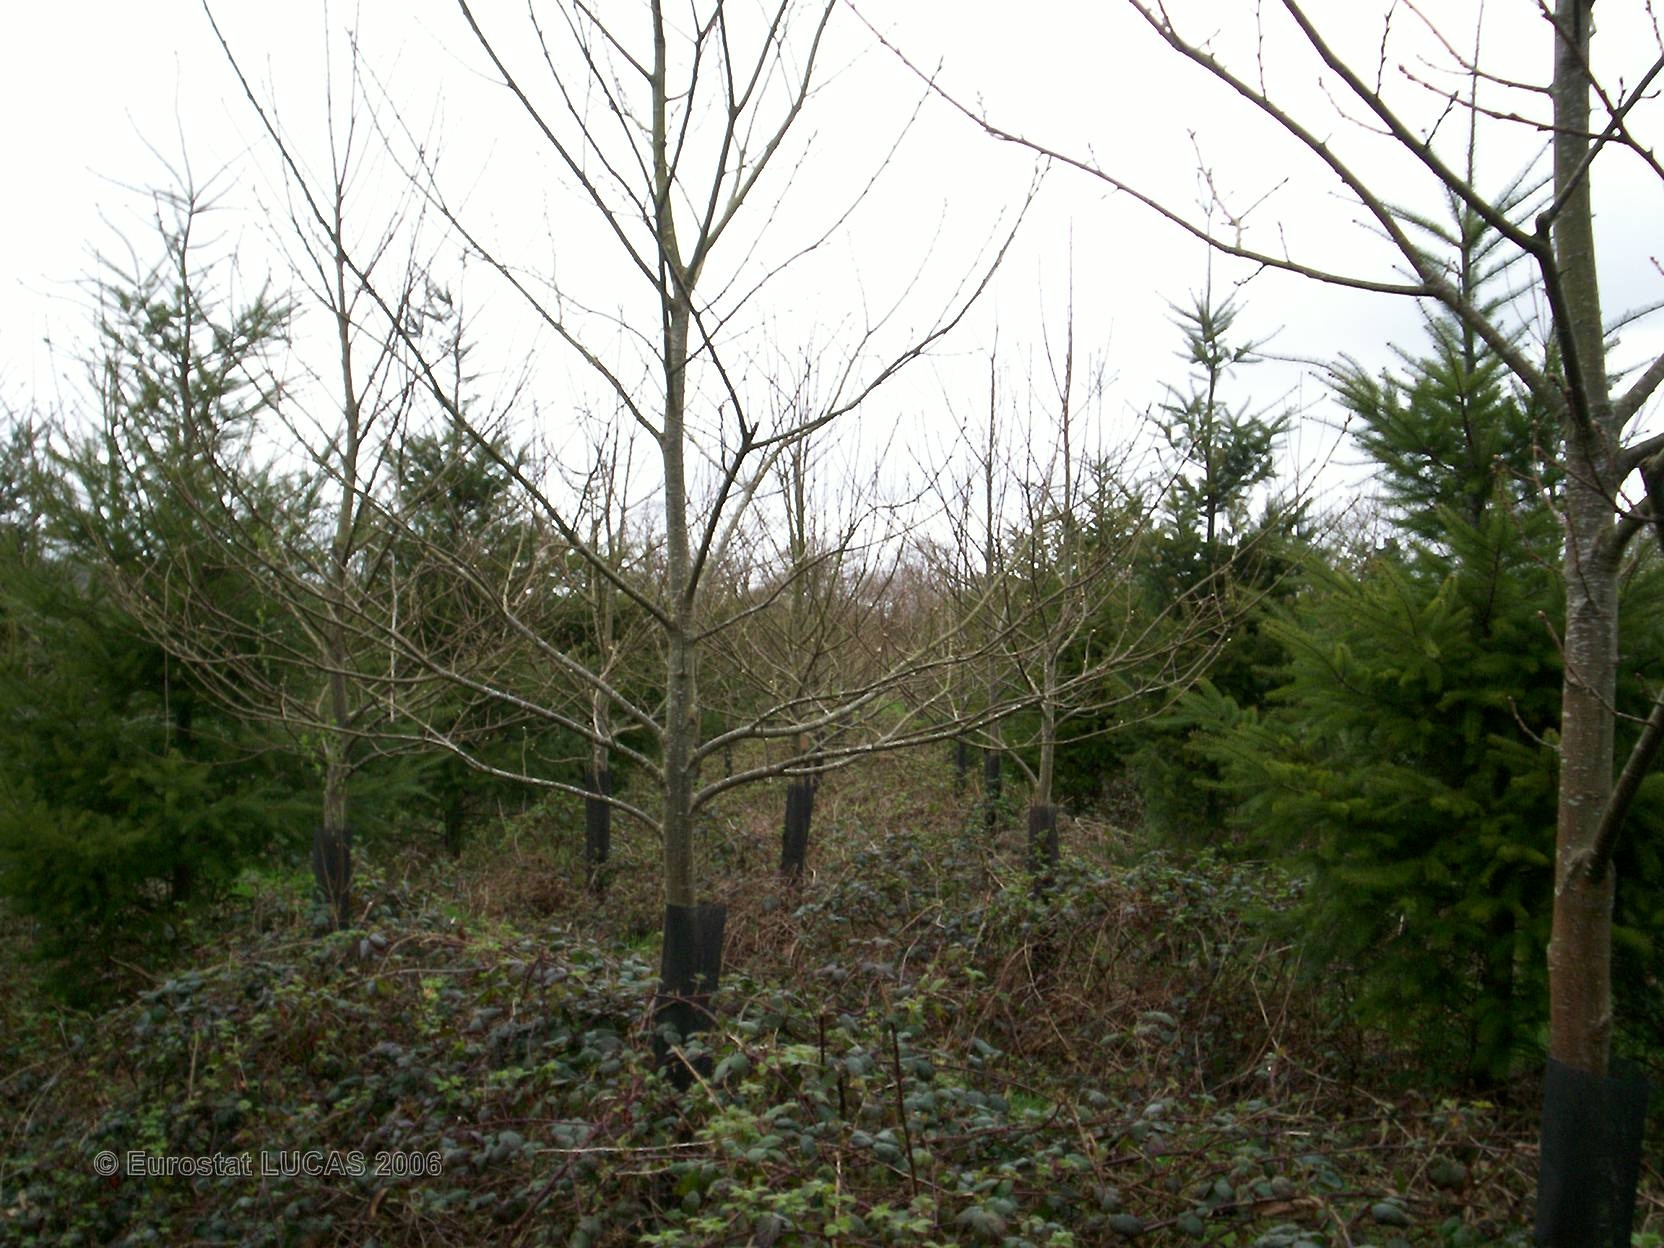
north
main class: Woodland
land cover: Coniferous forest
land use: Forestry
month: April
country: FR
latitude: 47.9961
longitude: -3.6007
